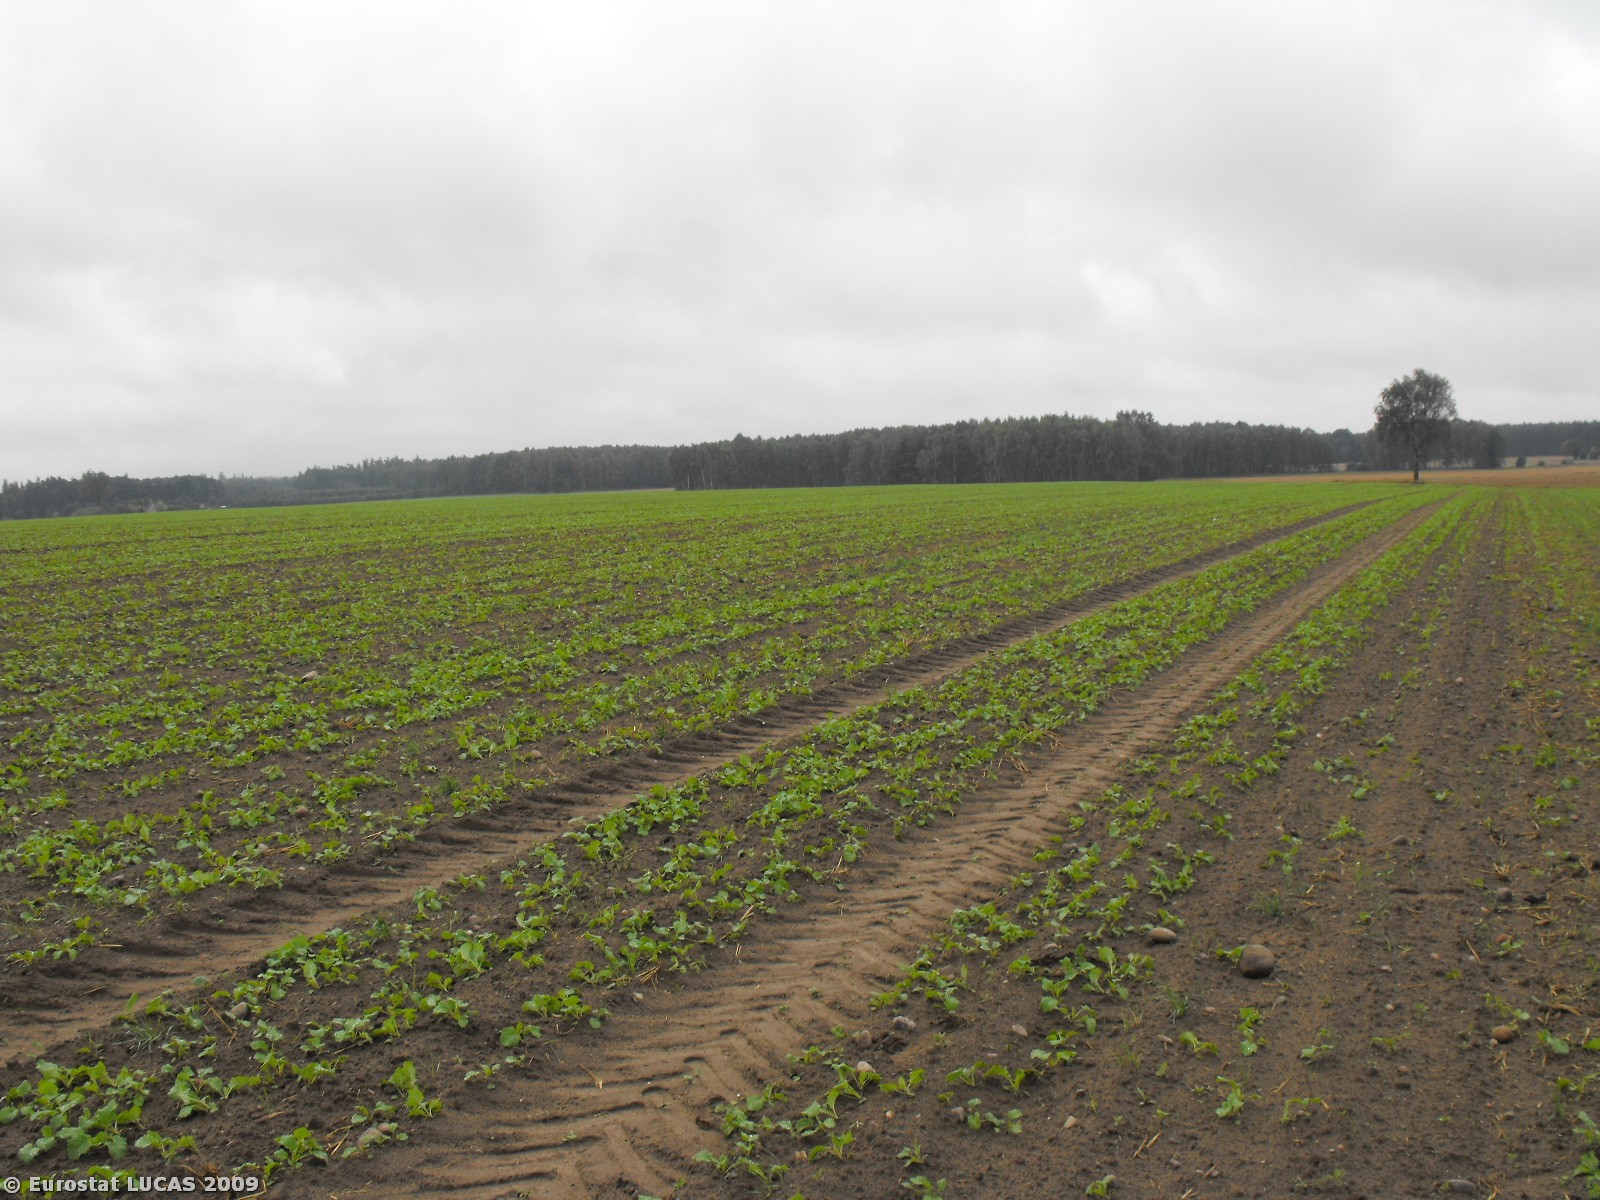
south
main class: Cropland
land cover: Triticale
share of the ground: < 10 %
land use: Agriculture (excluding fallow land and kitchen gardens)
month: September
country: PL
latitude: 53.4979
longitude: 17.1401
